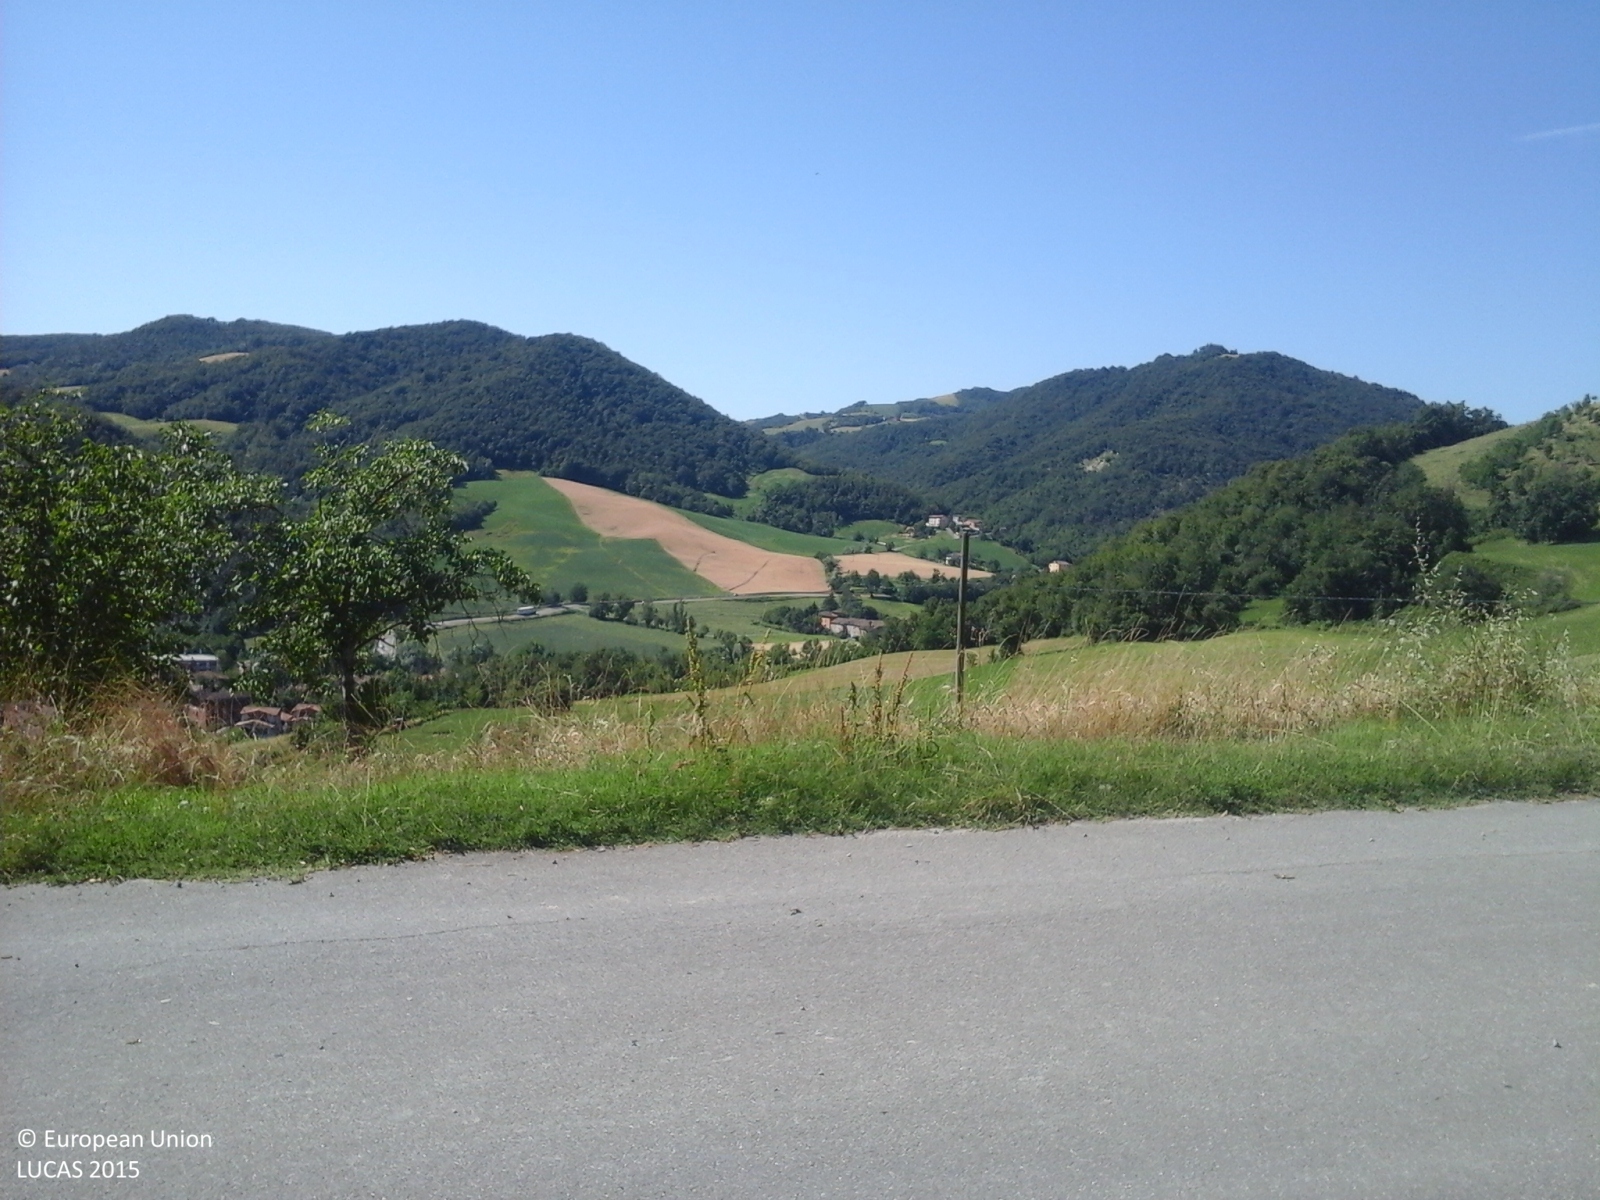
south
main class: Grassland
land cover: Grassland with sparse tree/shrub cover
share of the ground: > 75 %
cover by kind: herbaceous plants 90 %, broadleaved forest trees 5 %, shrubs 5 %
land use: Agriculture (excluding fallow land and kitchen gardens)
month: June
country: IT
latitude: 44.5471
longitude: 10.6154
